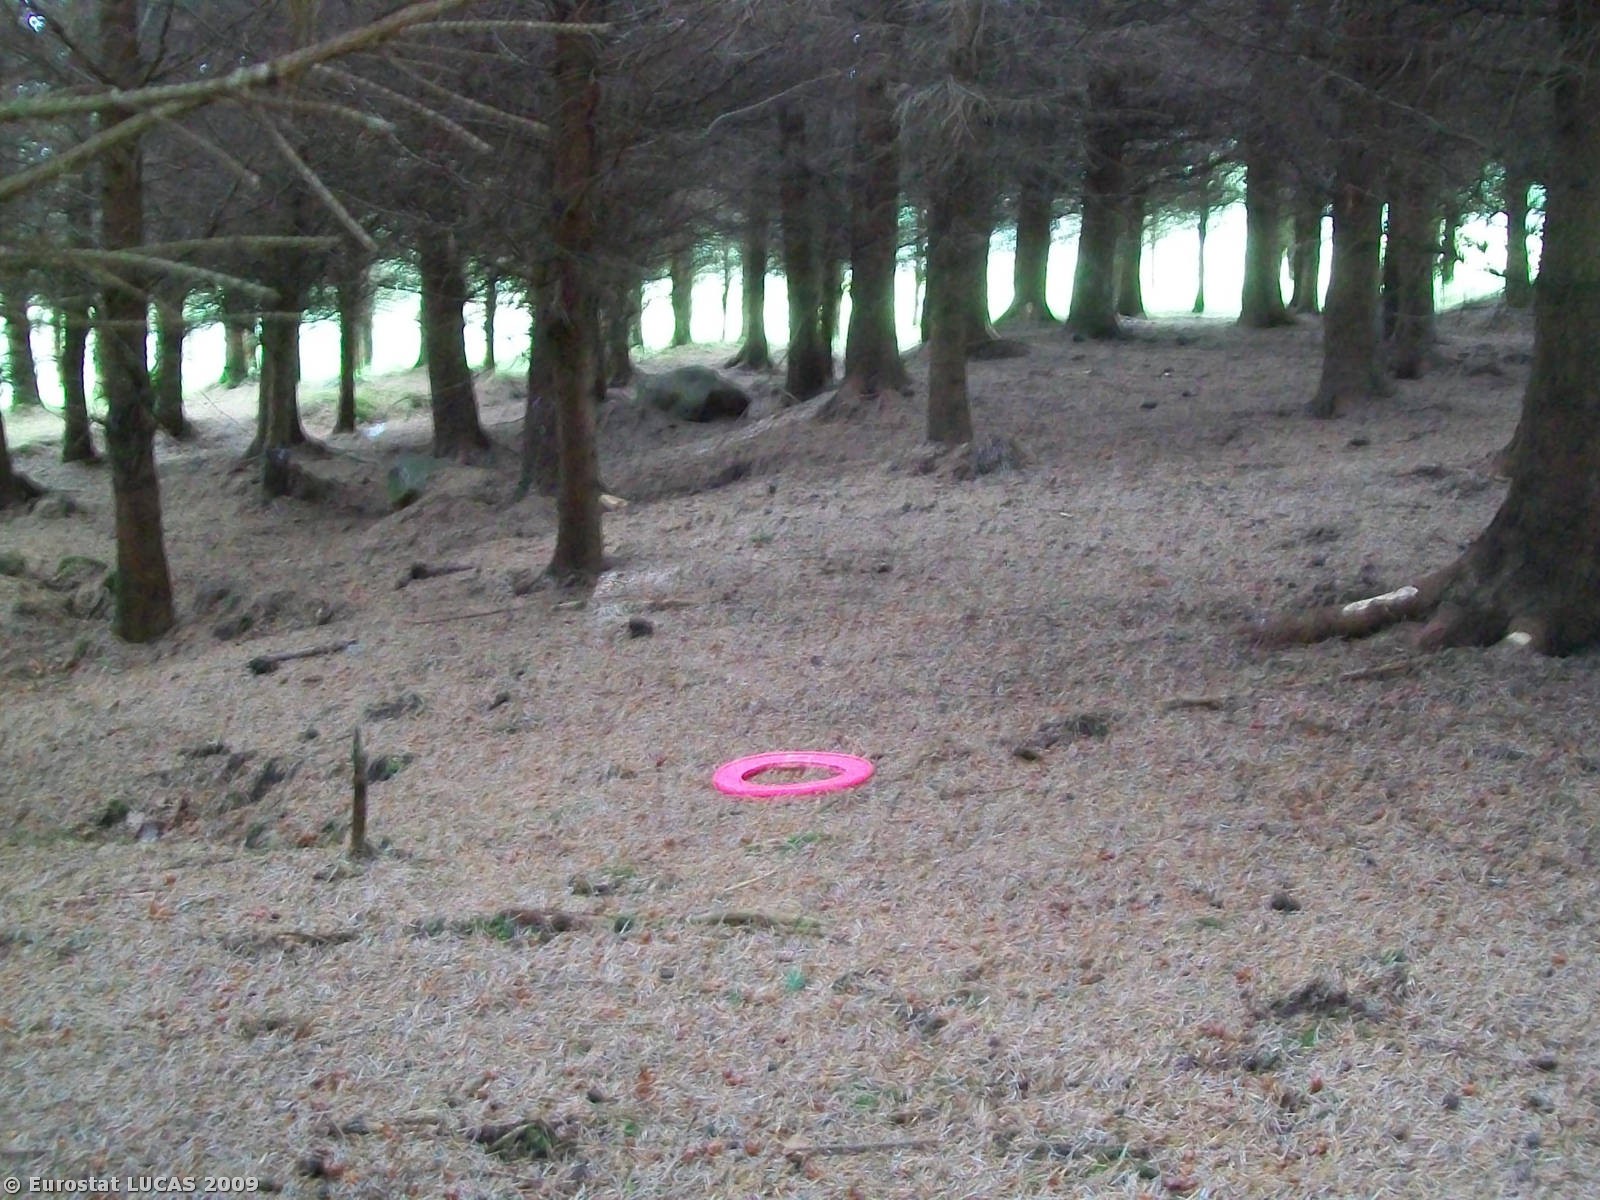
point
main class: Woodland
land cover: Coniferous woodland
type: plantations and self-sown exotic forest
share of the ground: > 75 %
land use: Forestry
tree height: > 5 m
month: July
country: GB
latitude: 54.8975
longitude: -6.8334
